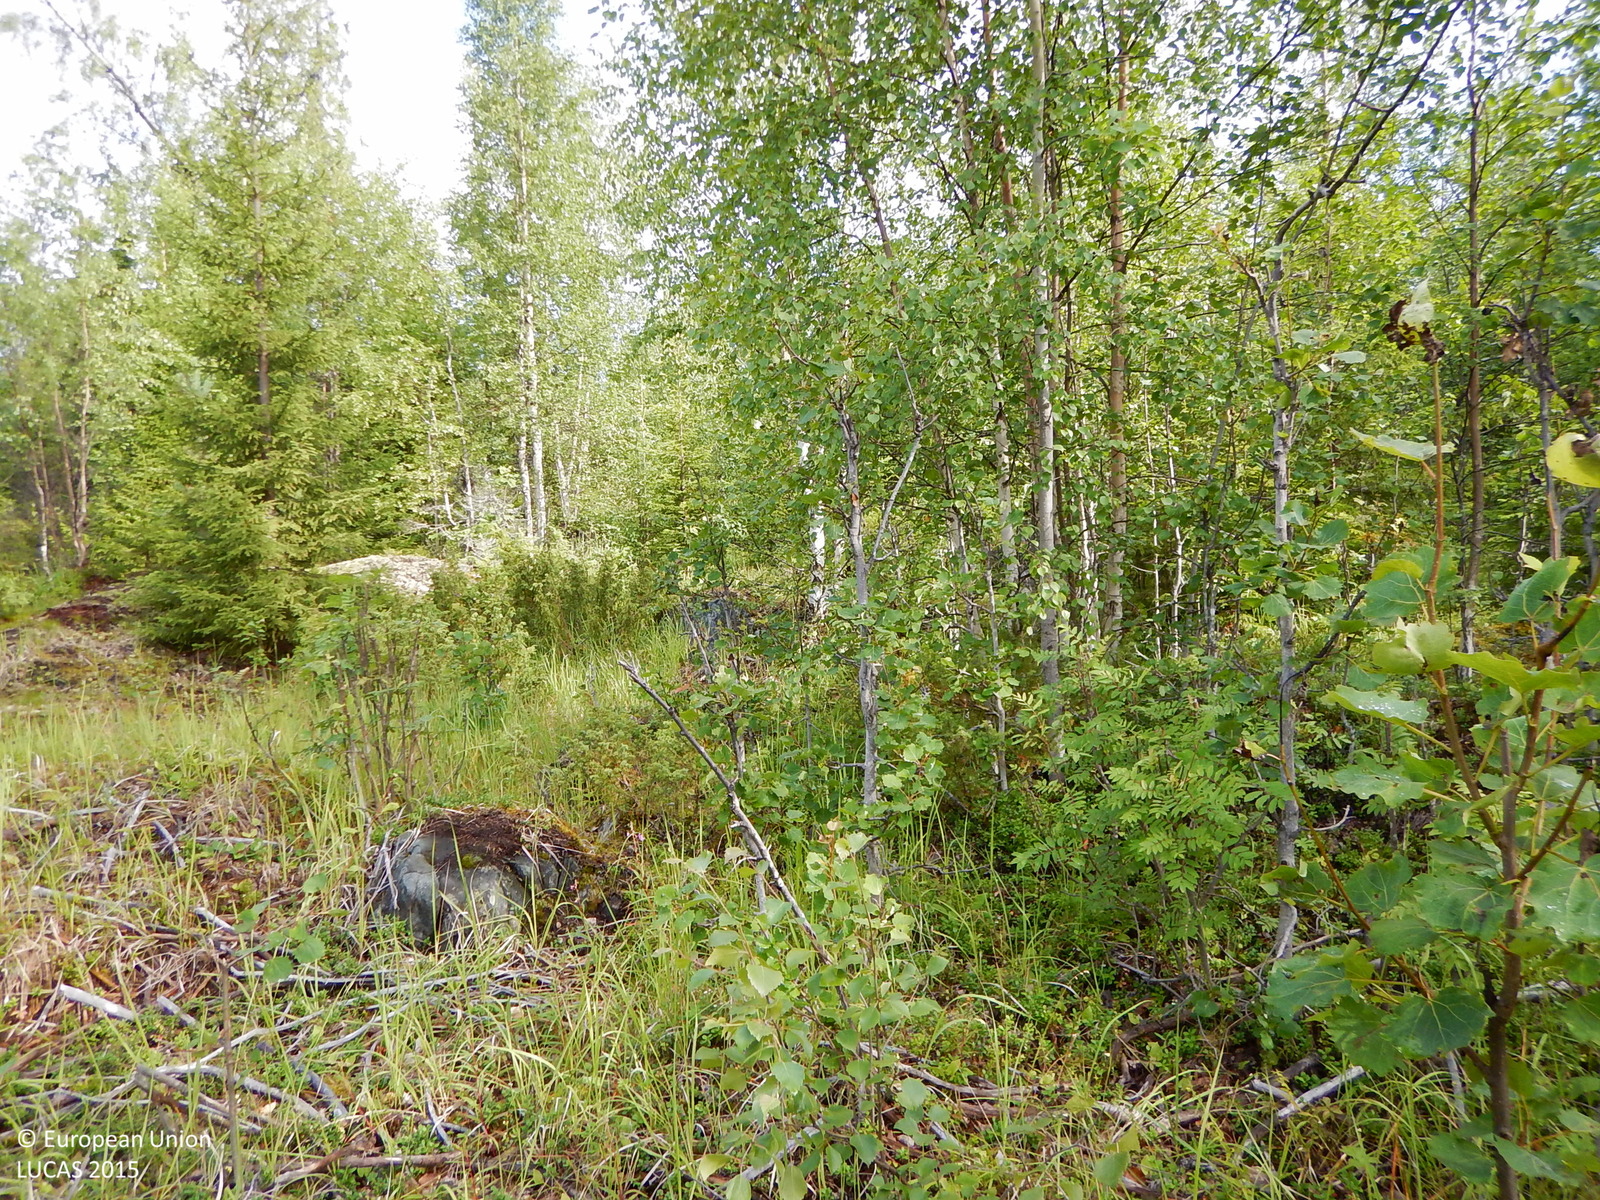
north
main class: Woodland
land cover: Broadleaved woodland
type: boreal forest
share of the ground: 50 - 75 %
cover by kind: broadleaved forest trees 50 %, shrubs 20 %, herbaceous plants 20 %, coniferous forest trees 10 %
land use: Forestry
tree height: > 5 m
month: July
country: SE
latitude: 64.8004
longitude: 20.7323
